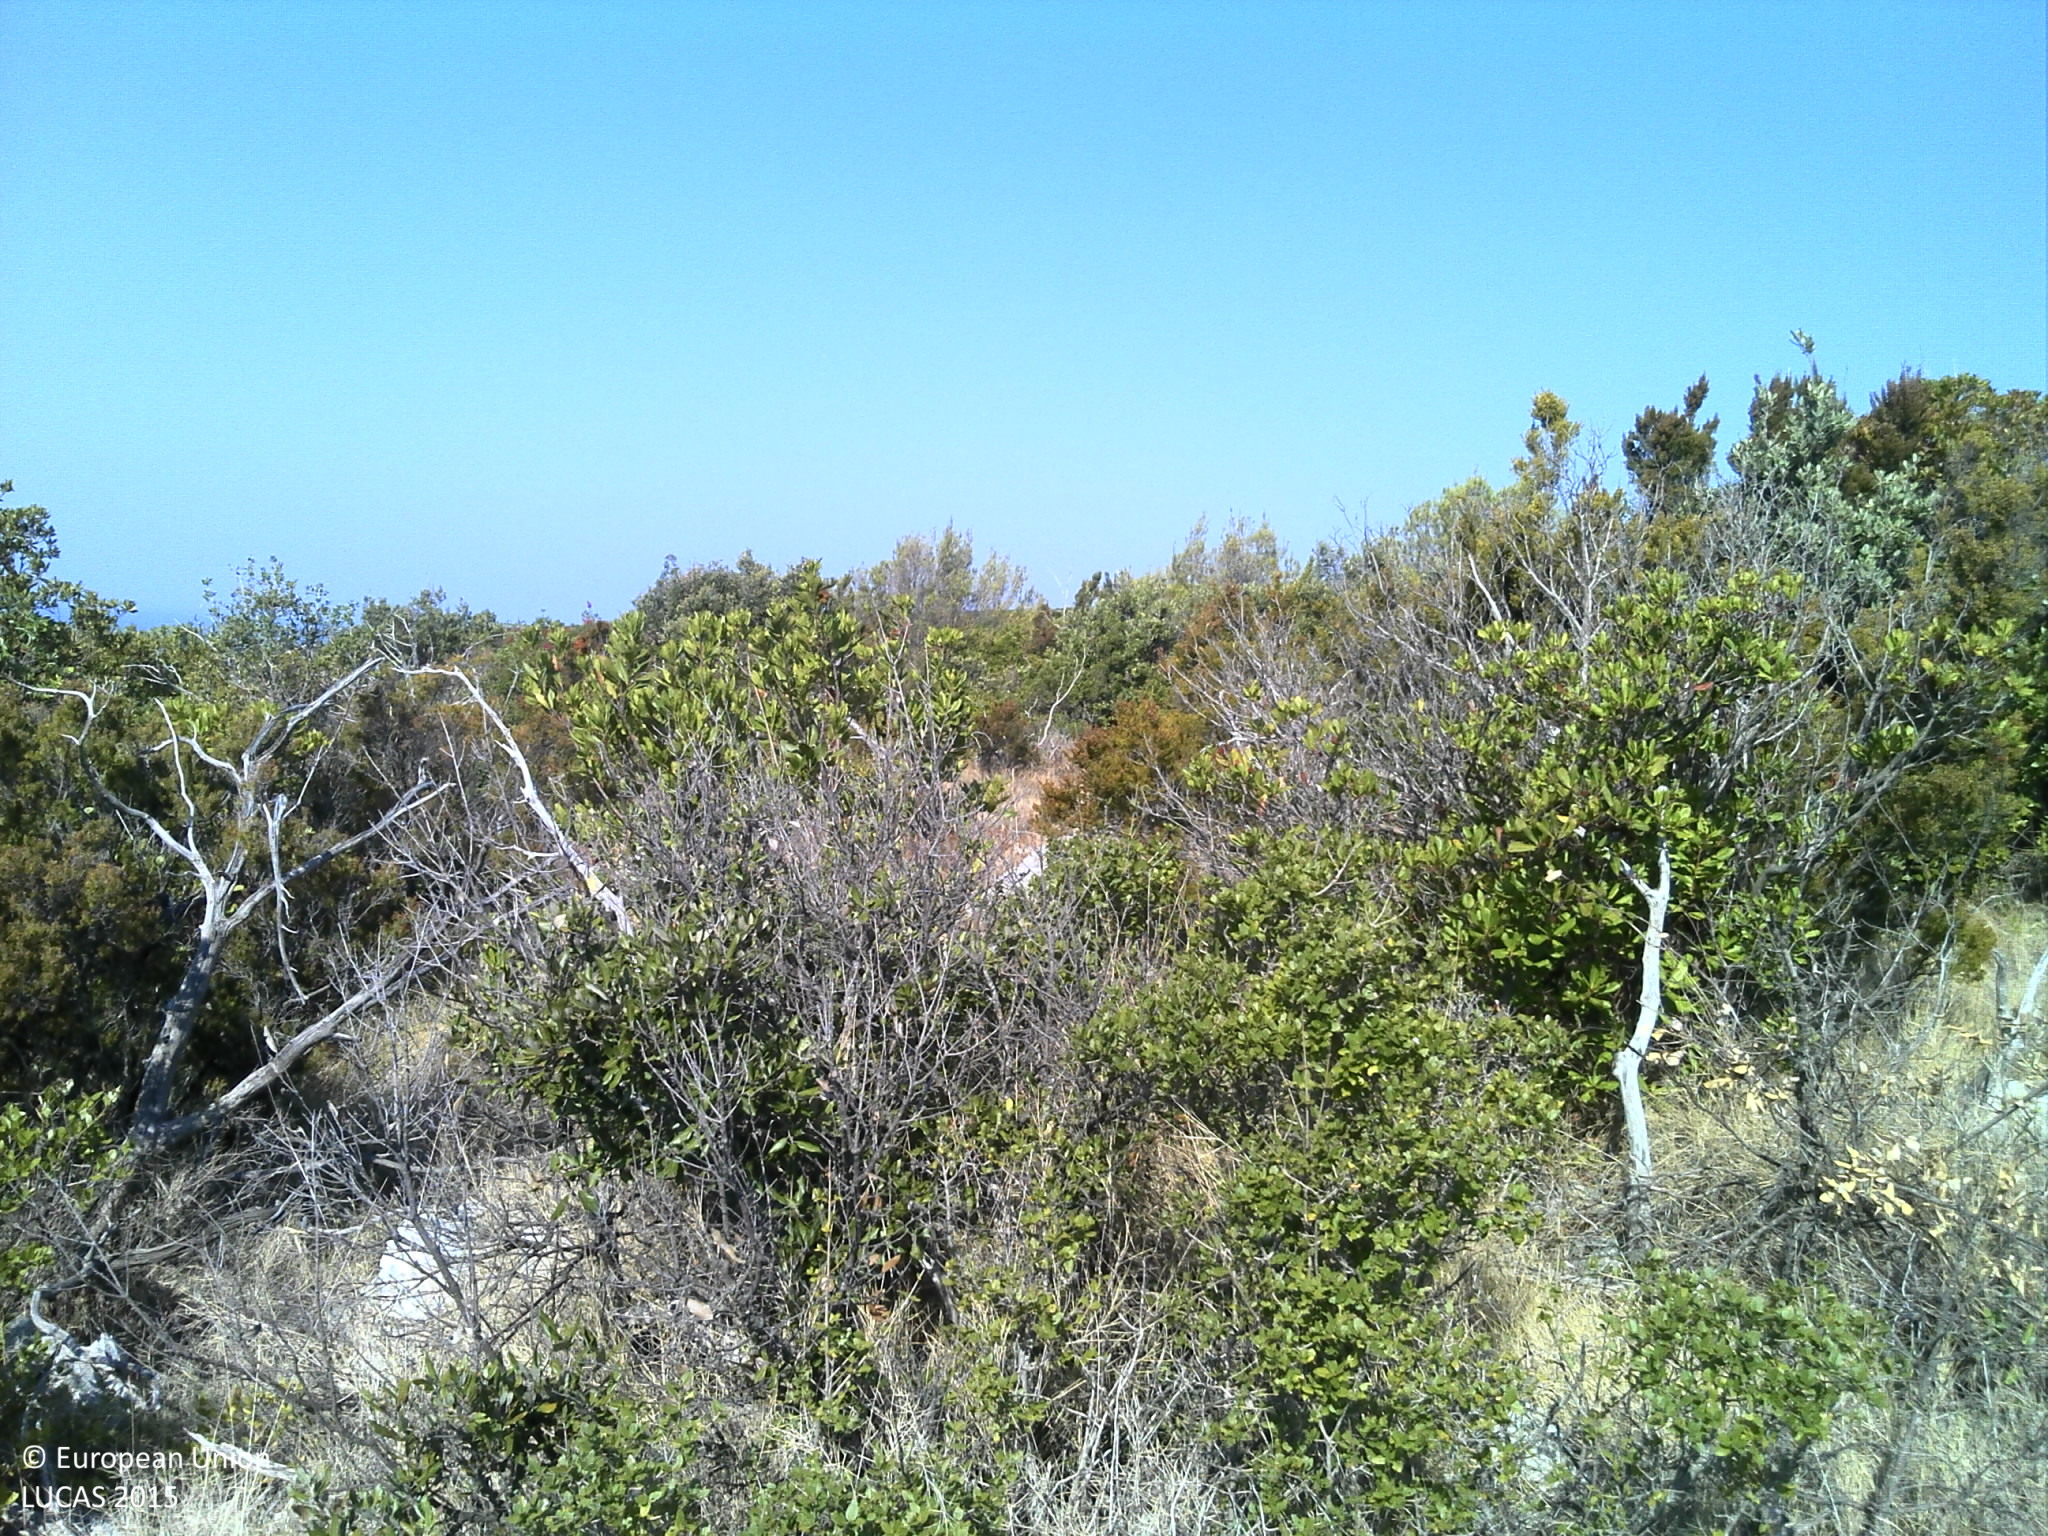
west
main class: Shrubland
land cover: Shrubland with sparse tree cover
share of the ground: > 75 %
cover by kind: shrubs 75 %, herbaceous plants 10 %, broadleaved forest trees 5 %, consolidated bare surface 5 %, unconsolidated bare surface 5 %
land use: Semi-natural and natural areas not in use
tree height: < 5 m
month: August
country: HR
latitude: 43.1277
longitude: 16.8611
